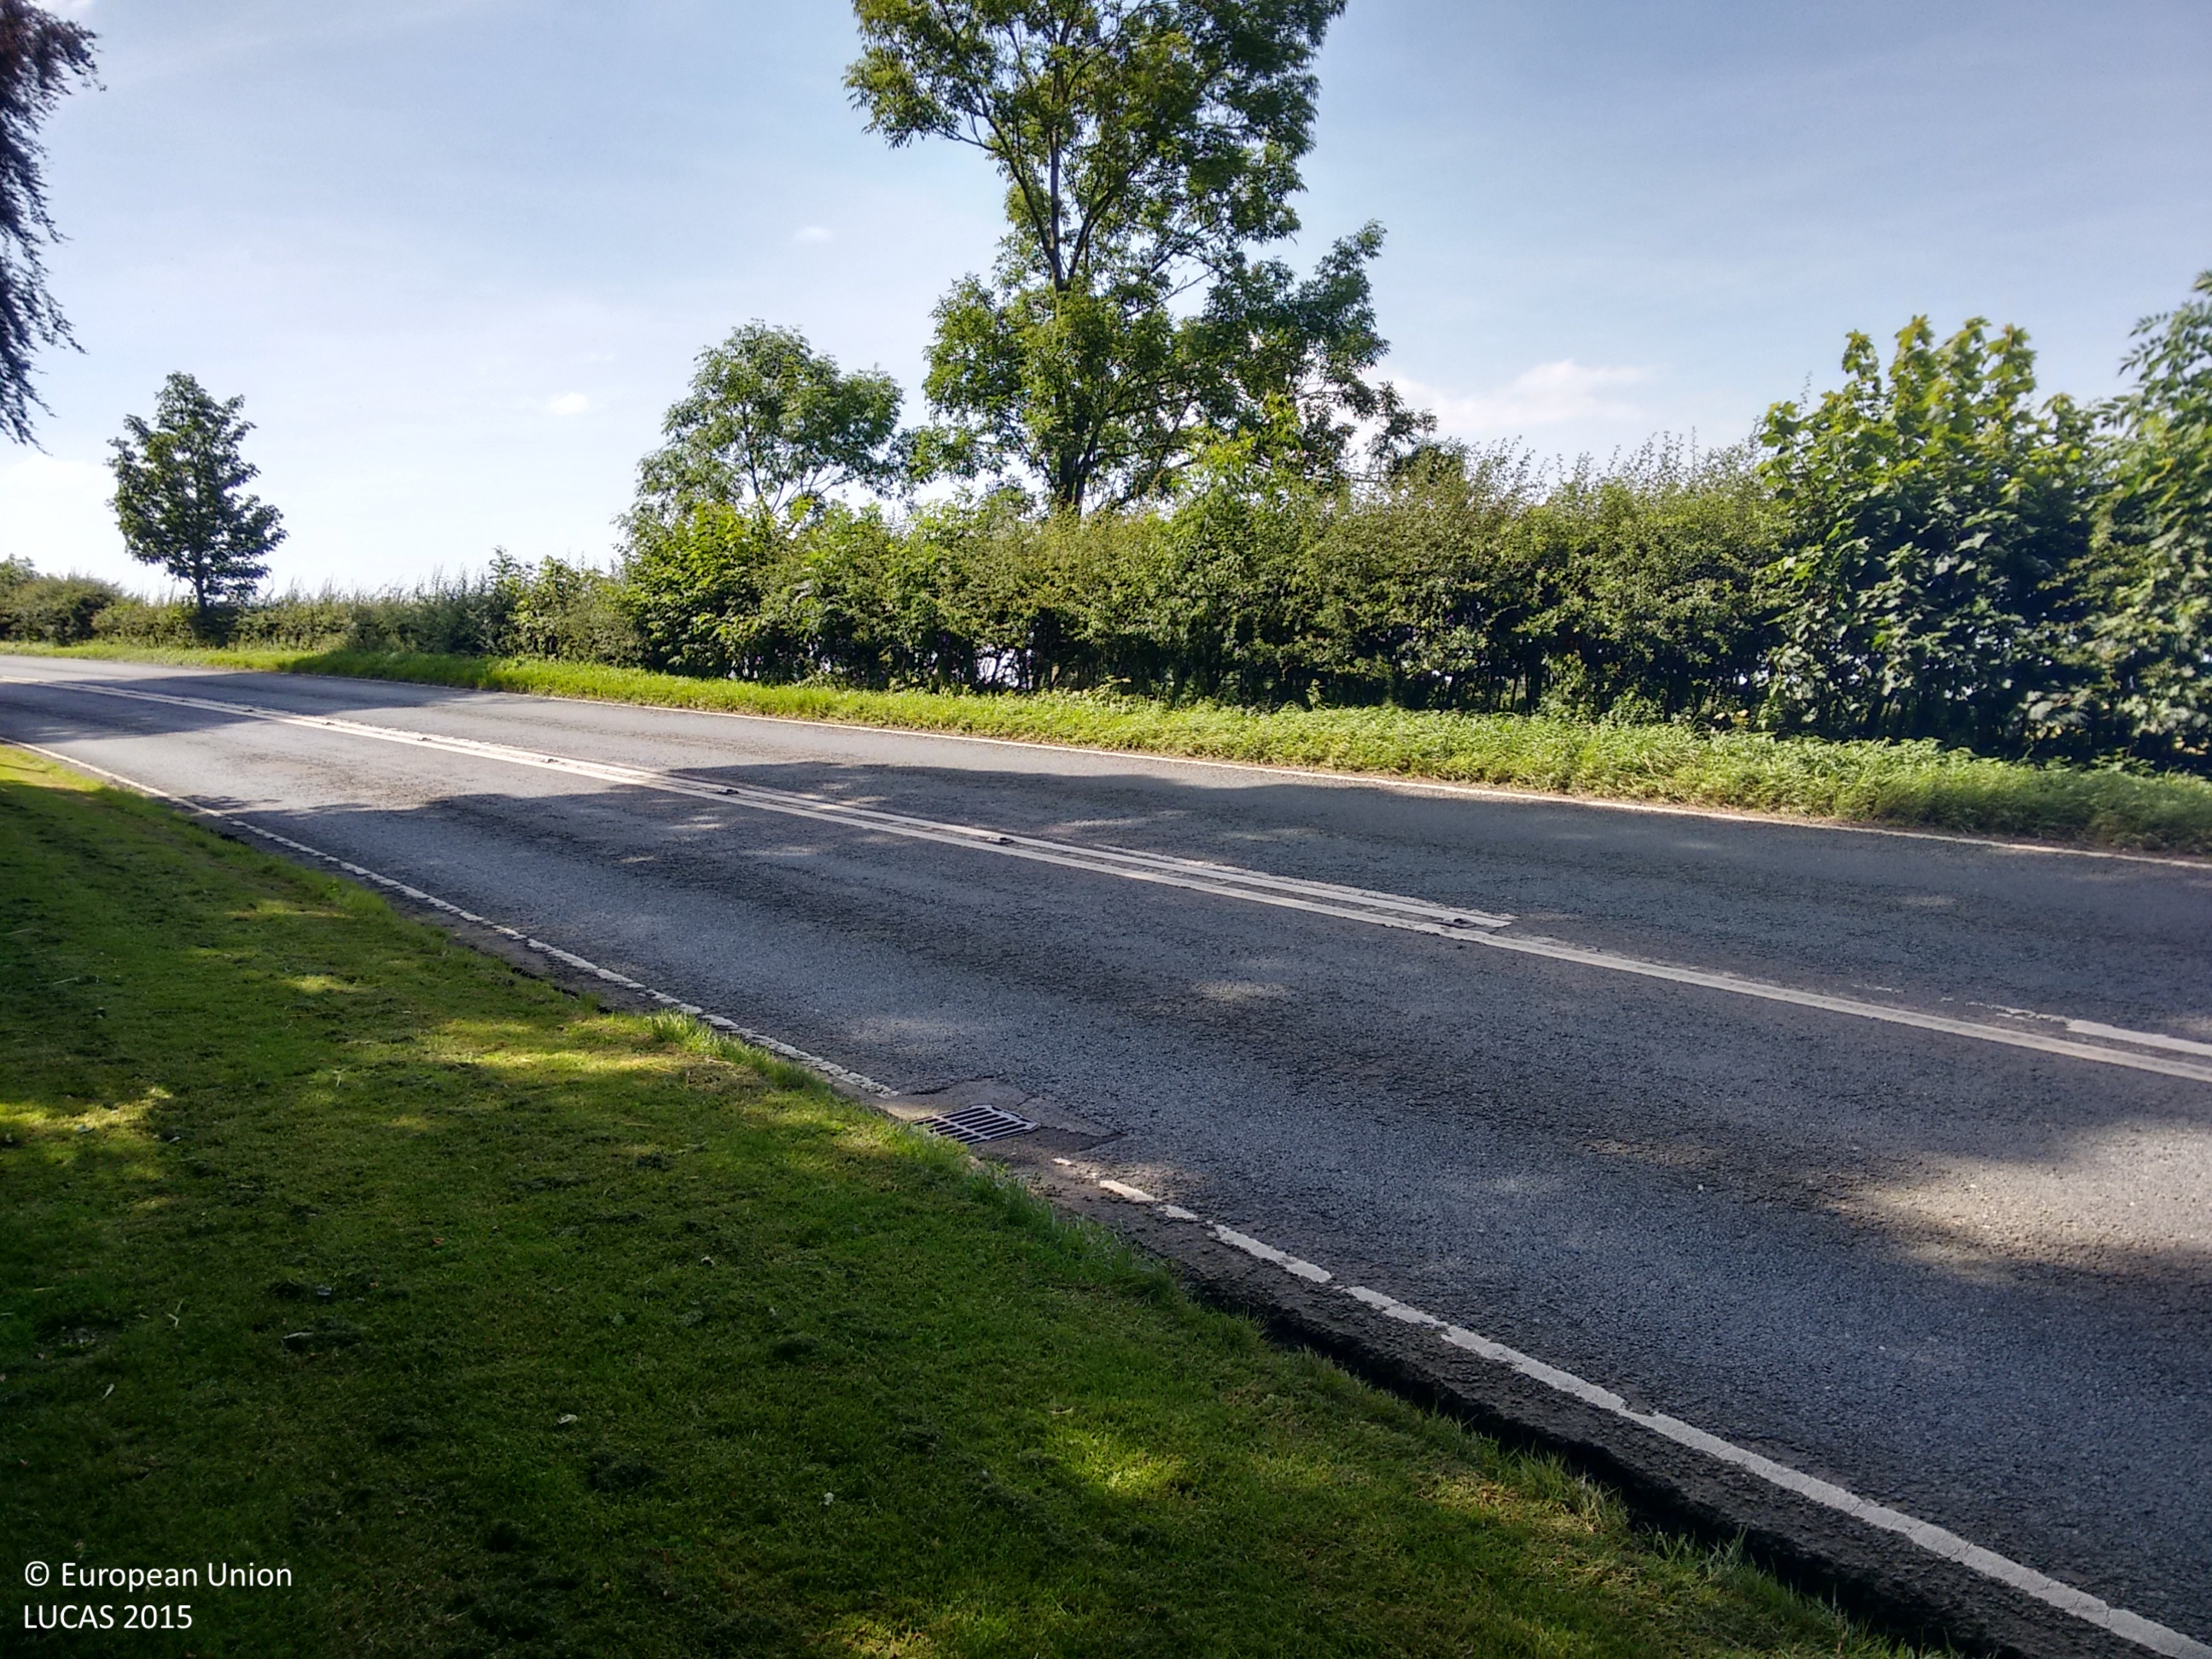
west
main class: Woodland
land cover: Broadleaved woodland
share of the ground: > 75 %
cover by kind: broadleaved forest trees 70 %, herbaceous plants 30 %
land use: Agriculture (excluding fallow land and kitchen gardens)
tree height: > 5 m
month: August
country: GB
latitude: 54.7468
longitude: -3.2662
